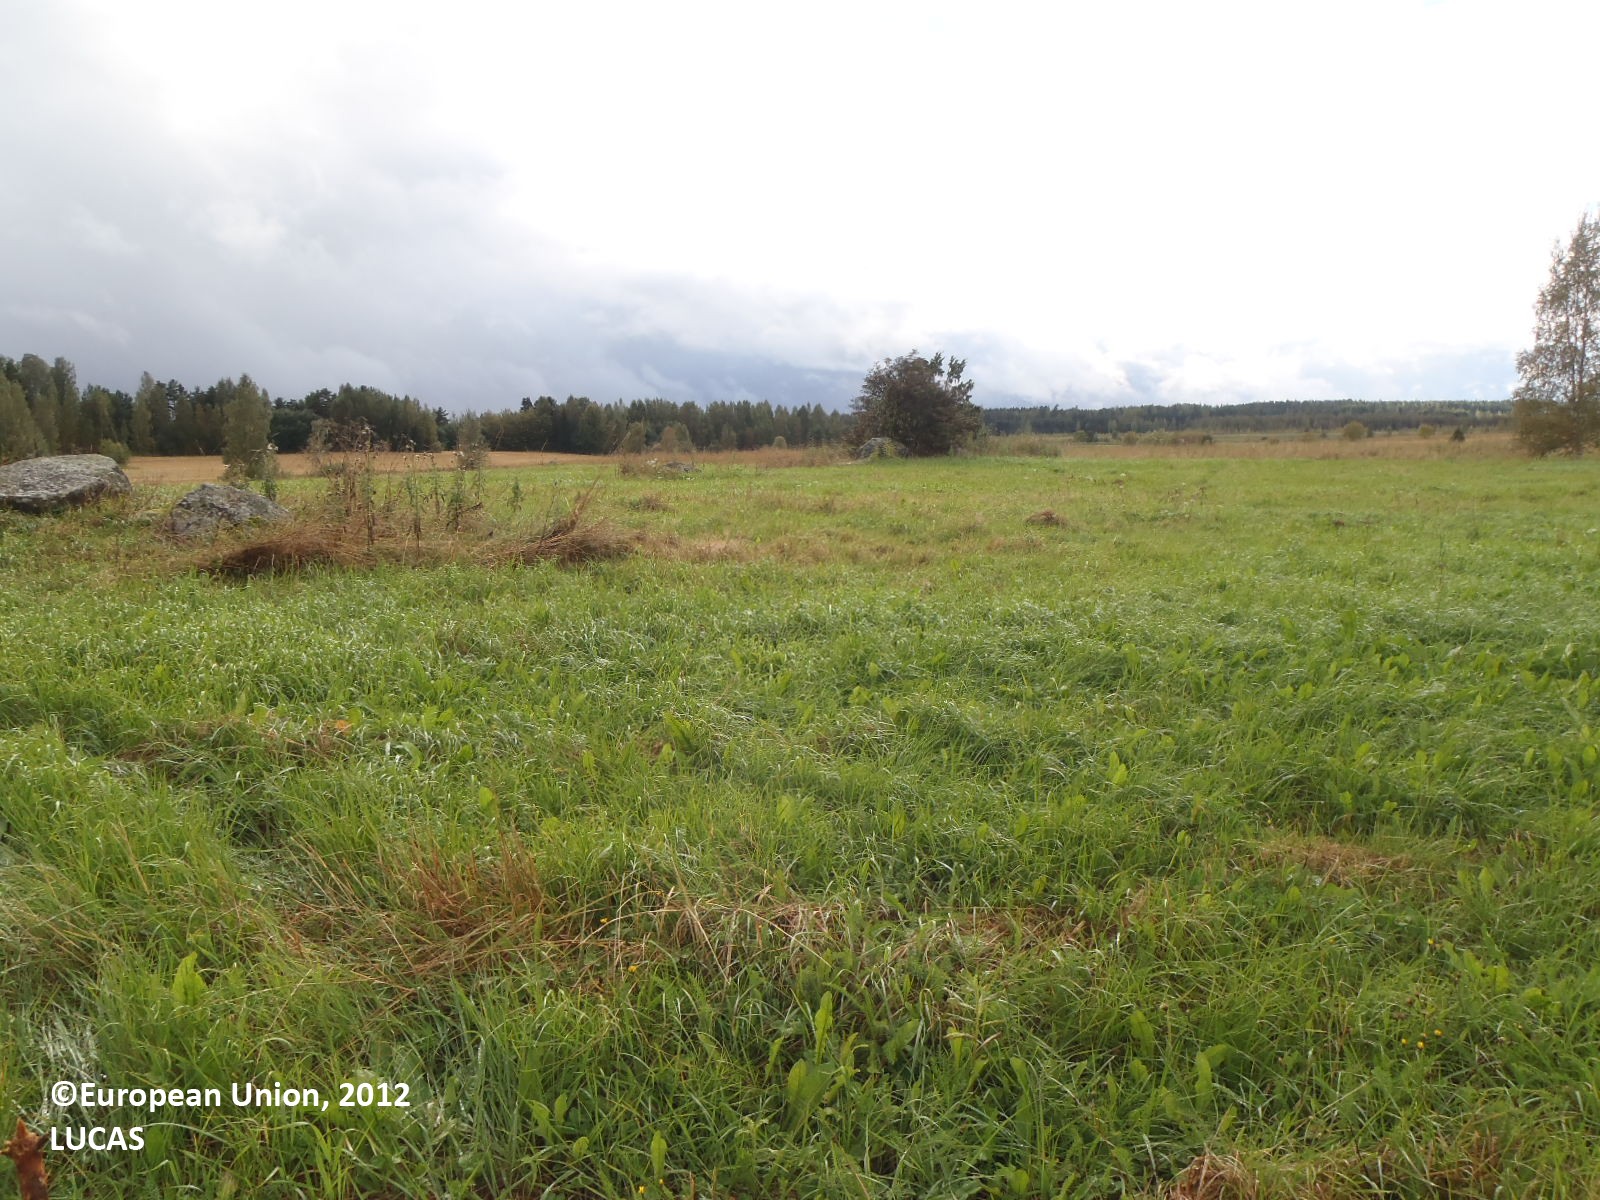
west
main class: Grassland
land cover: Grassland without tree/shrub cover
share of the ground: > 75 %
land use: Agriculture (excluding fallow land and kitchen gardens)
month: September
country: FI
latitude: 61.6113
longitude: 22.5255
